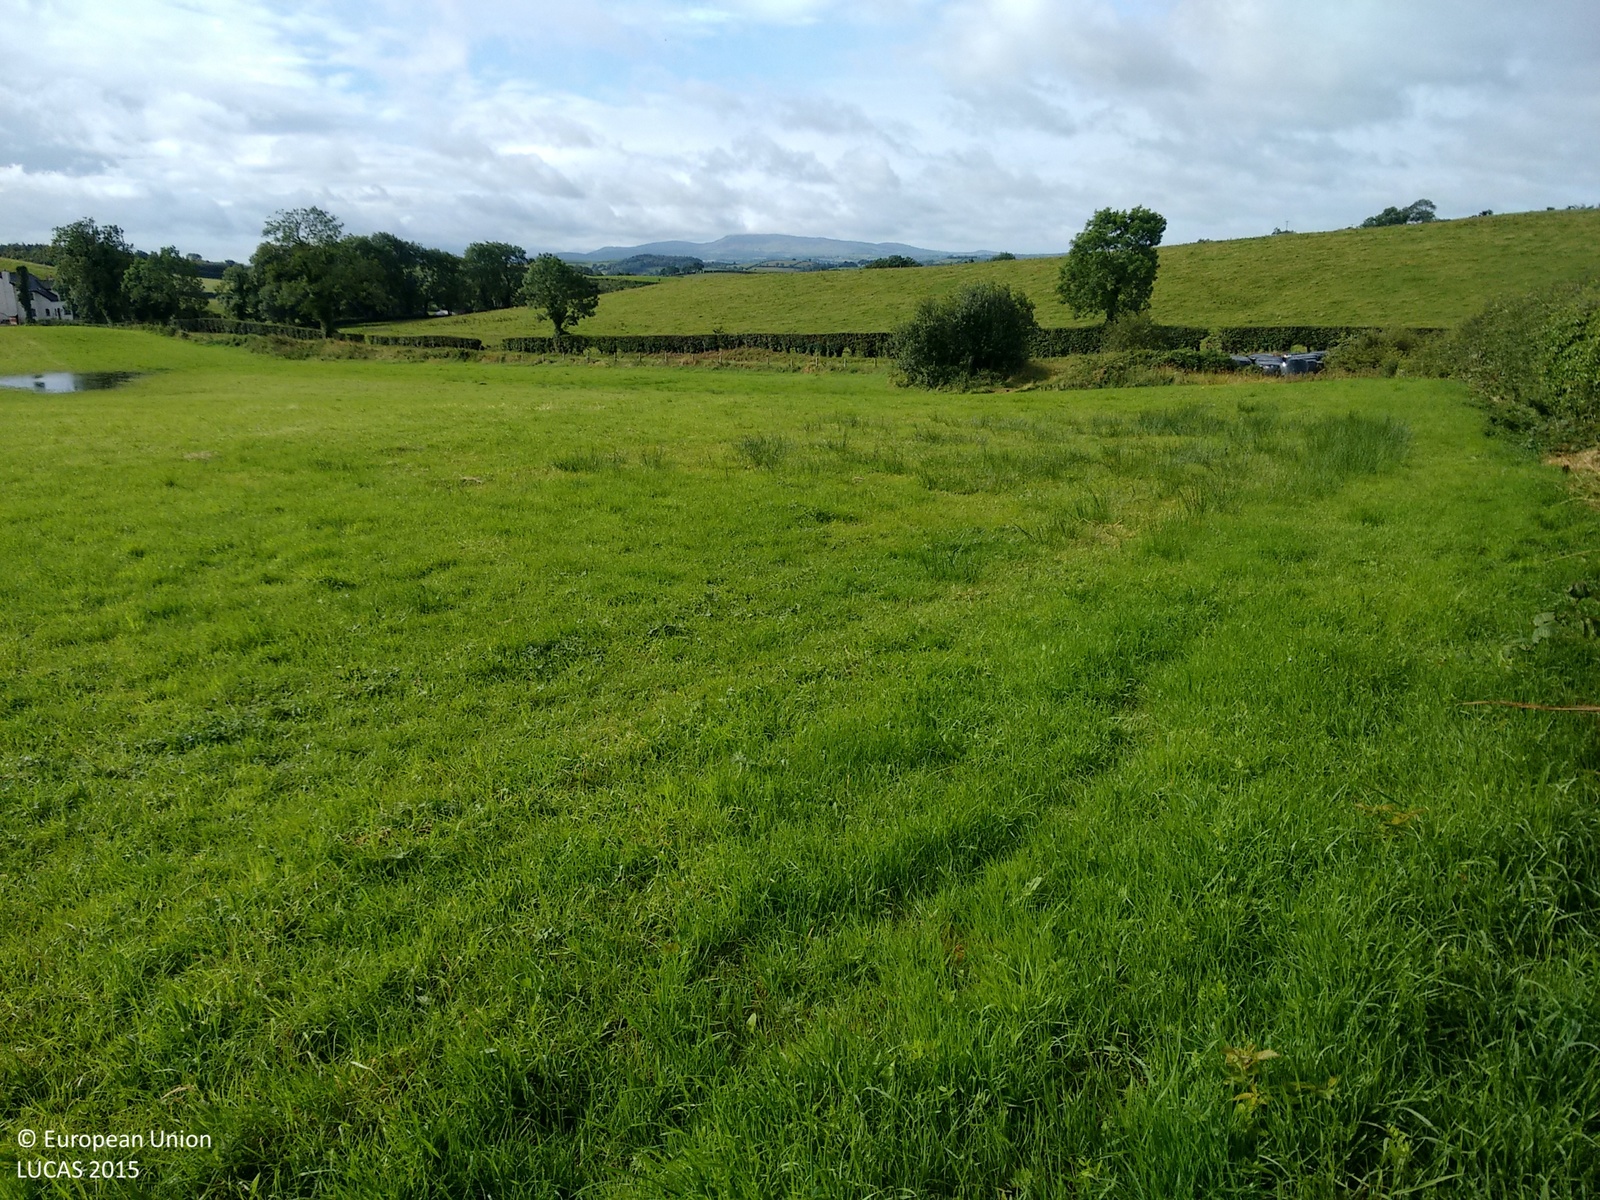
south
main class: Grassland
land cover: Grassland without tree/shrub cover
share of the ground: > 75 %
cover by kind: herbaceous plants 100 %
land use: Agriculture (excluding fallow land and kitchen gardens)
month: August
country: GB
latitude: 54.4715
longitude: -5.8926
